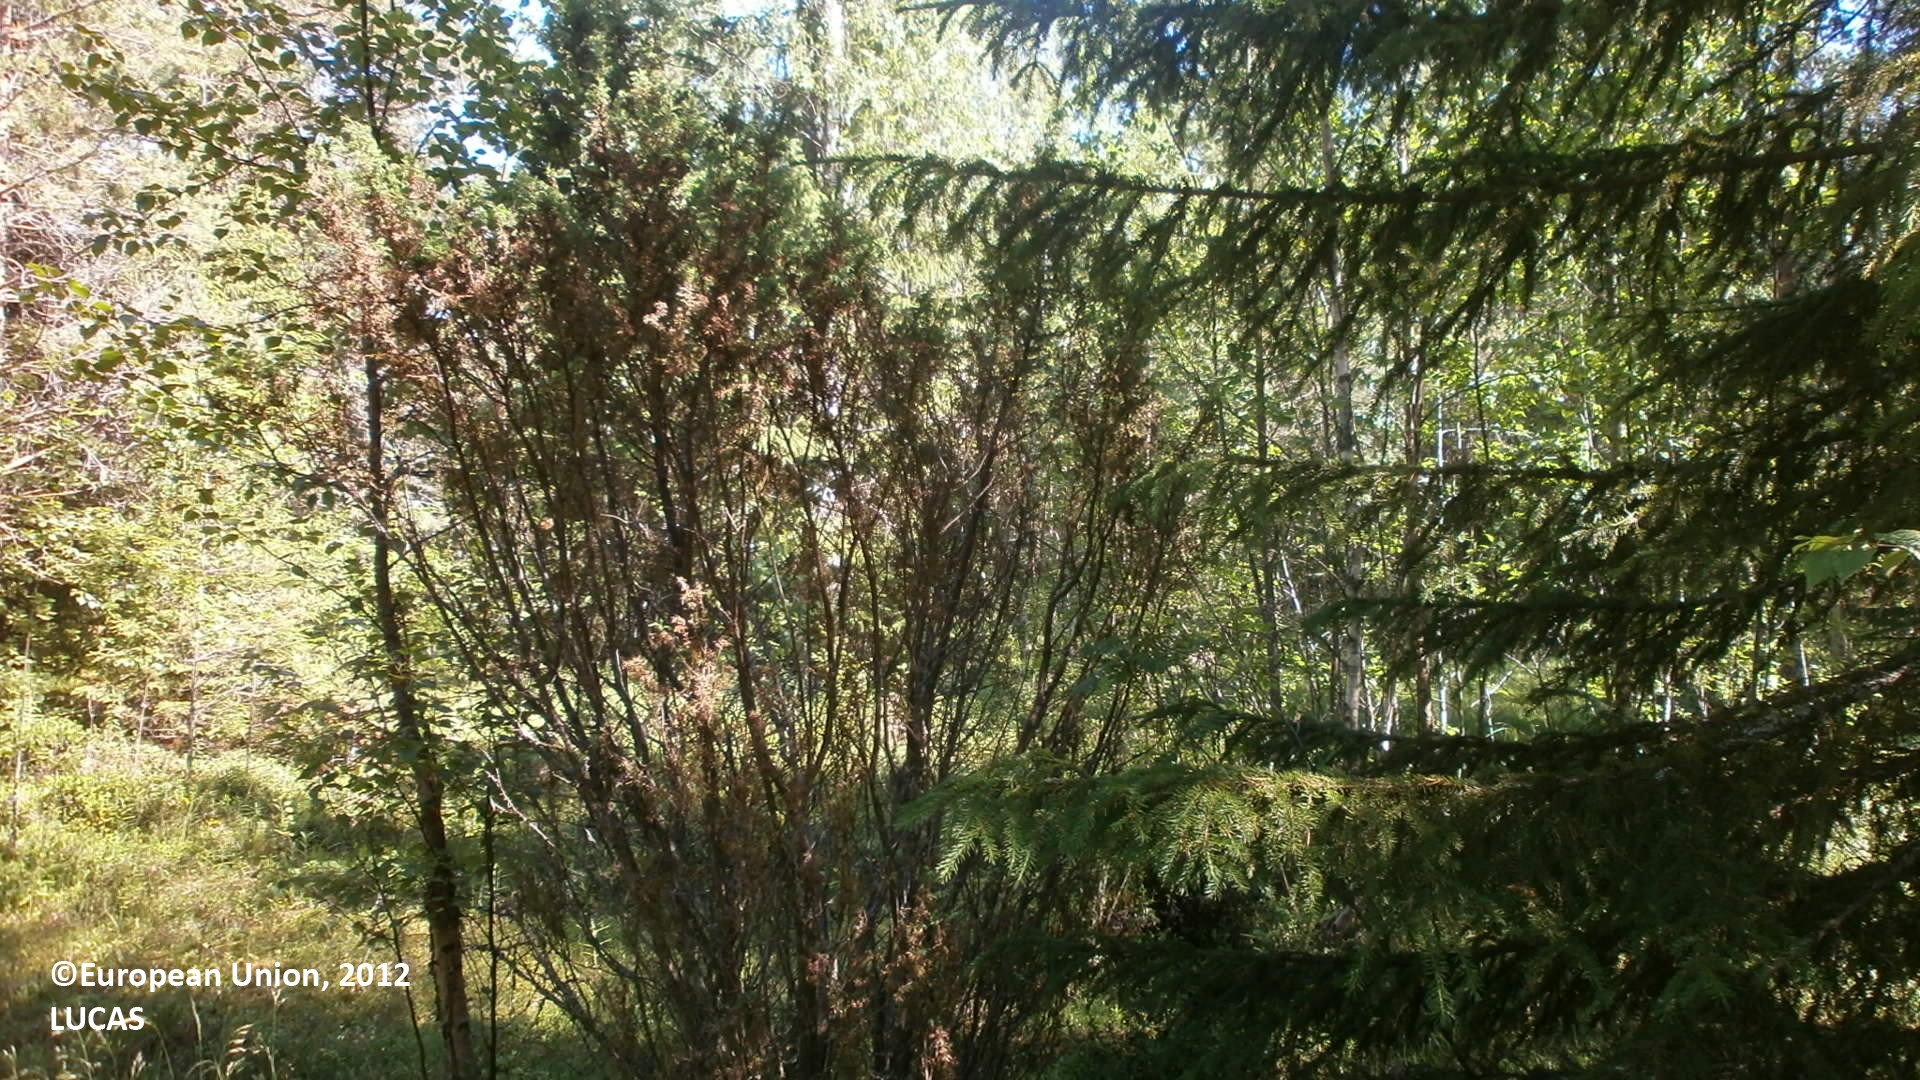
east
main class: Woodland
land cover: Pine dominated mixed woodland
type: boreal forest
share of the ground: 50 - 75 %
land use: Forestry
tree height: > 5 m
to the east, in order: Pine dominated mixed woodland; Tracks; Pine dominated mixed woodland; Pine dominated coniferous woodland
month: July
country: FI
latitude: 64.3235
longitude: 24.0249
